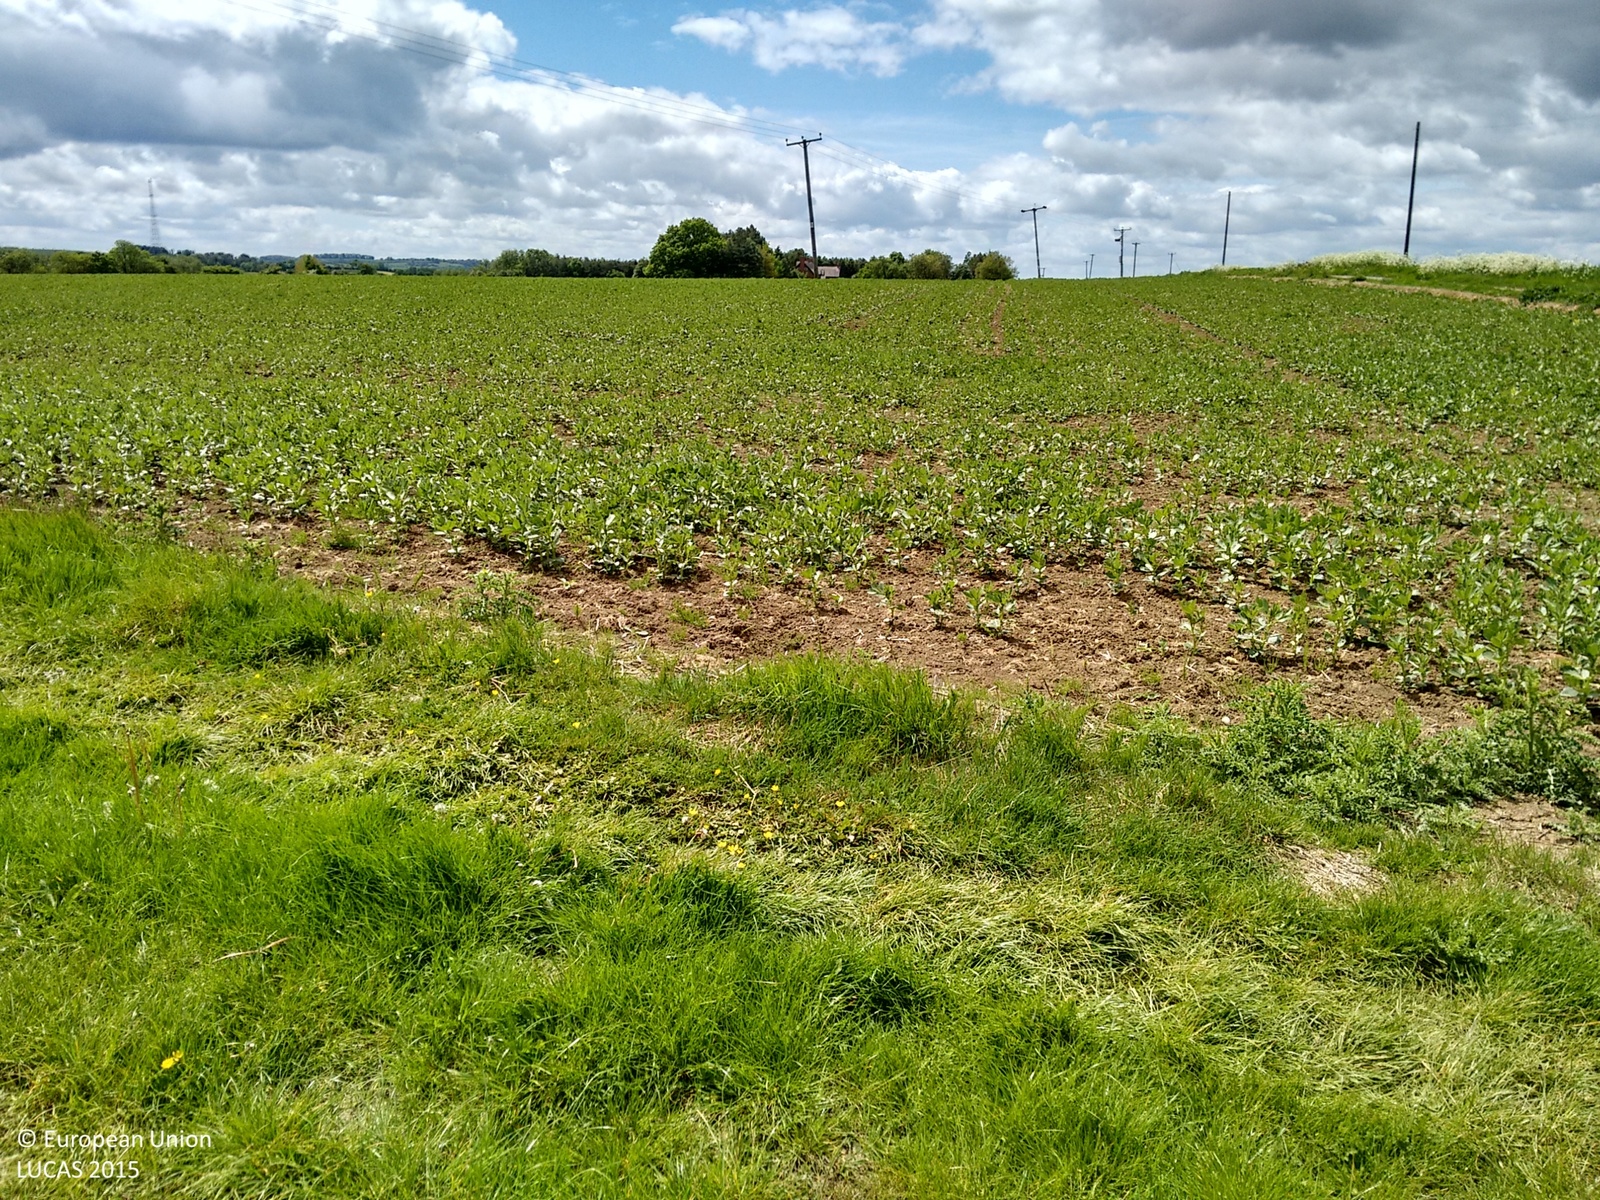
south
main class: Grassland
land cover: Grassland without tree/shrub cover
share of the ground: > 75 %
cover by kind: herbaceous plants 100 %
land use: Agriculture (excluding fallow land and kitchen gardens)
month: May
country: GB
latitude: 52.2113
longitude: -1.3620
